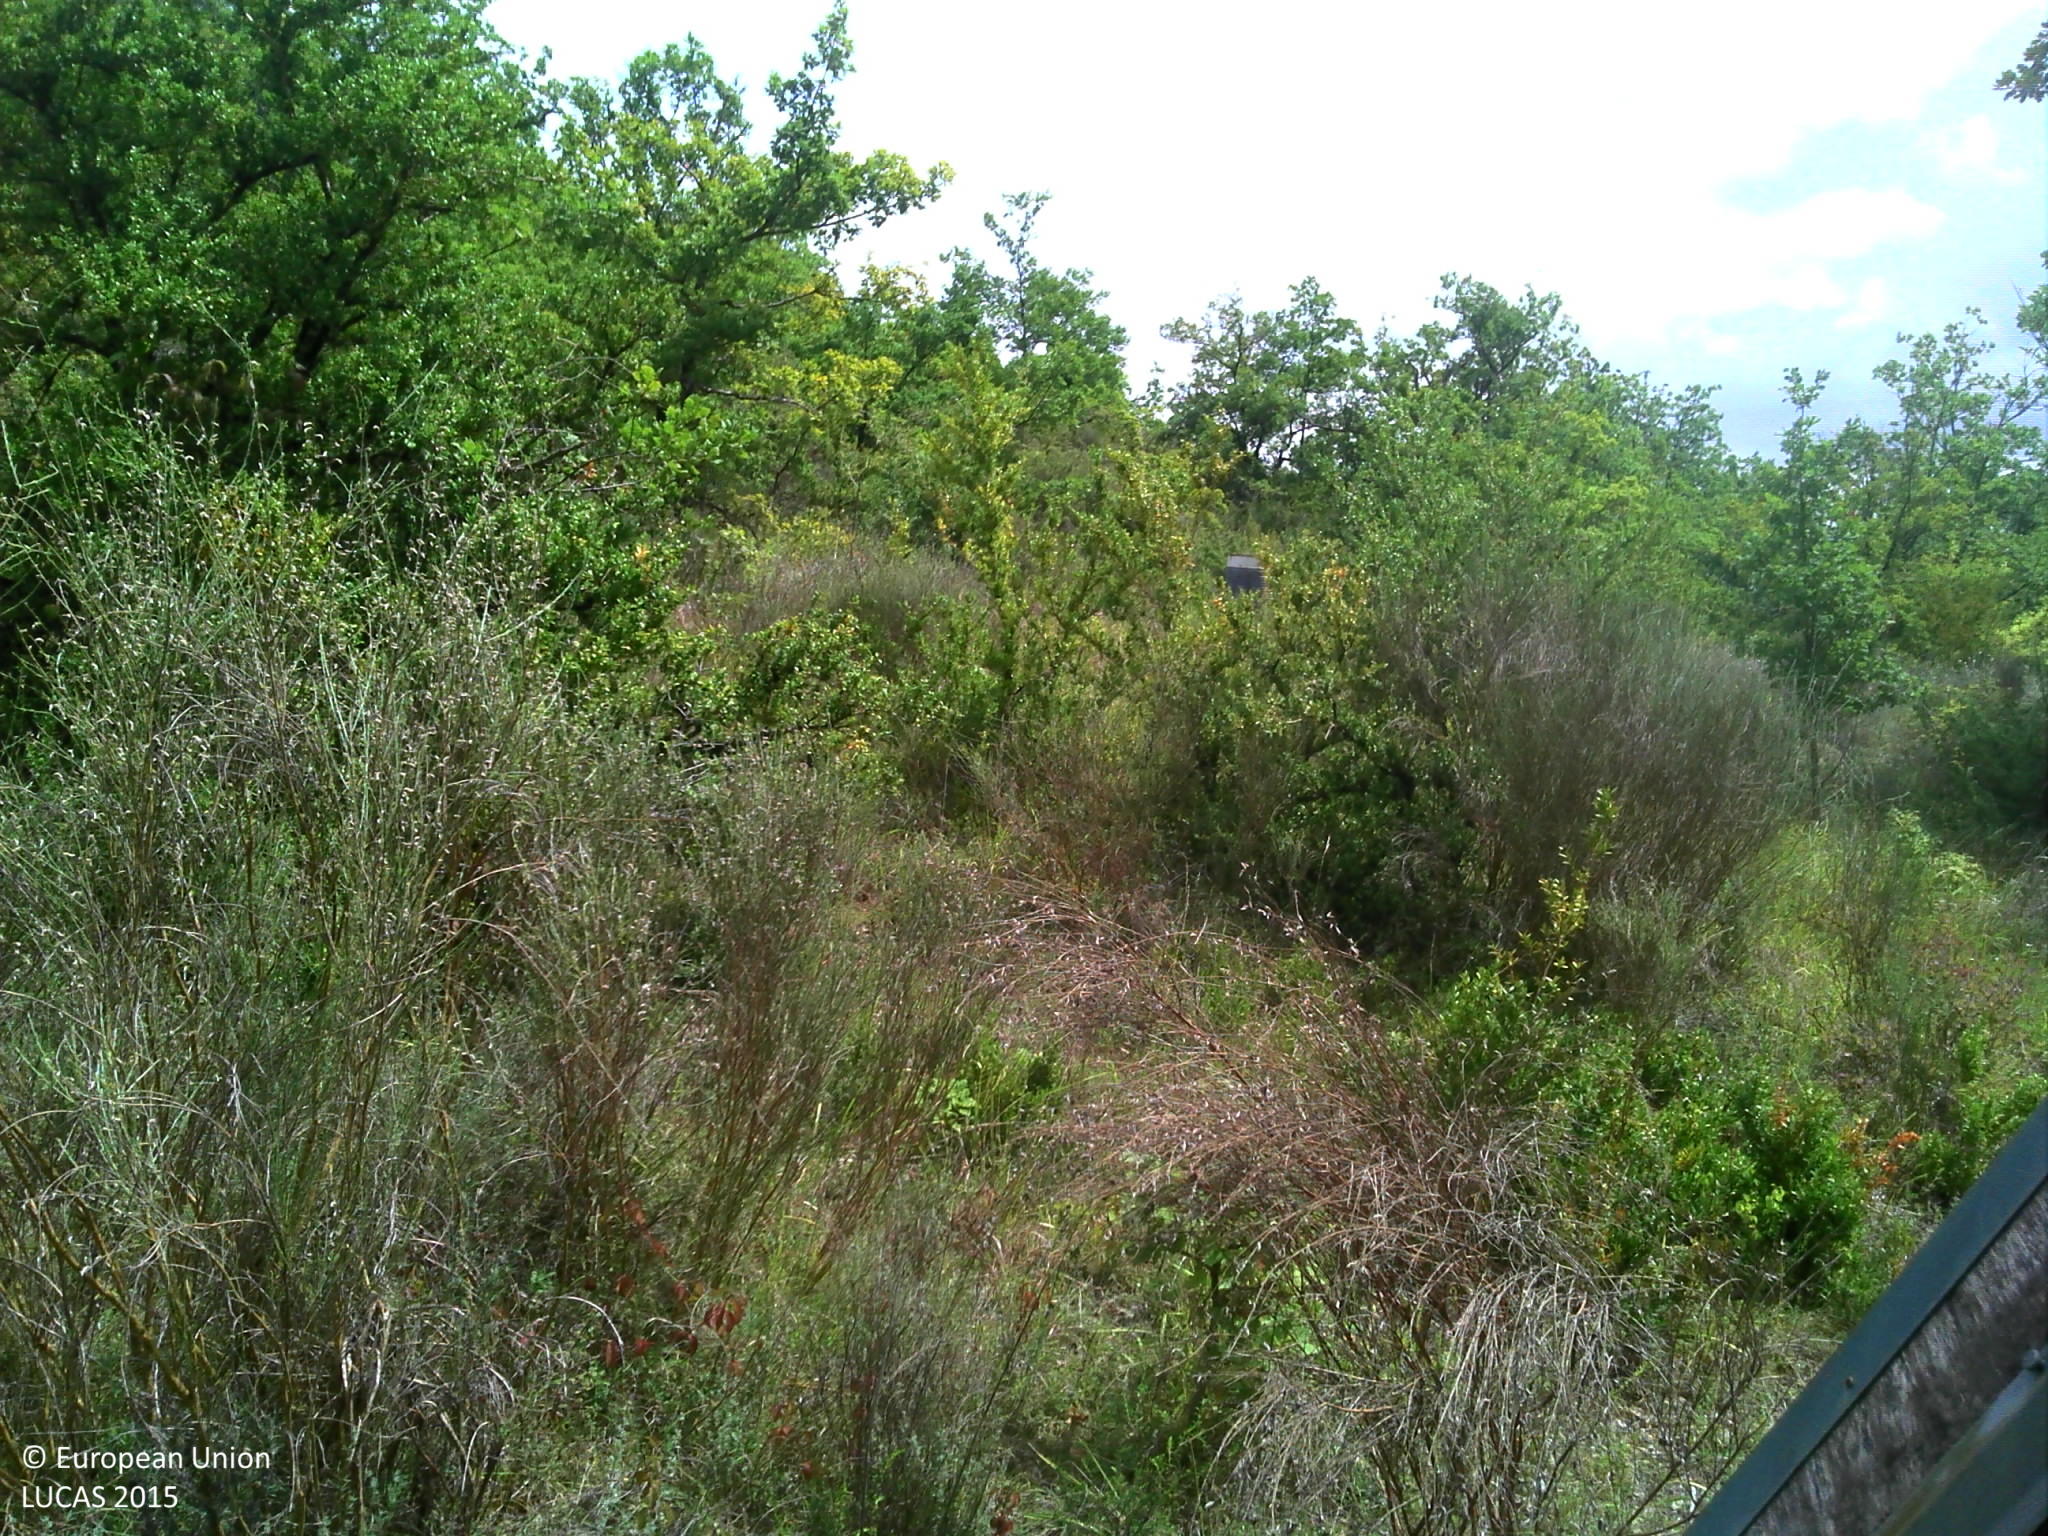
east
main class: Shrubland
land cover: Shrubland with sparse tree cover
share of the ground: > 75 %
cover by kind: shrubs 65 %, herbaceous plants 30 %, broadleaved forest trees 5 %
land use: Semi-natural and natural areas not in use
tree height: > 5 m
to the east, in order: Shrubland with sparse tree cover; Rock outcrops; Shrubland with sparse tree cover; Tracks; Dry stone walls; Shrubland with sparse tree cover; Broadleaved woodland
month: August
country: FR
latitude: 44.3476
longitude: 1.3047
